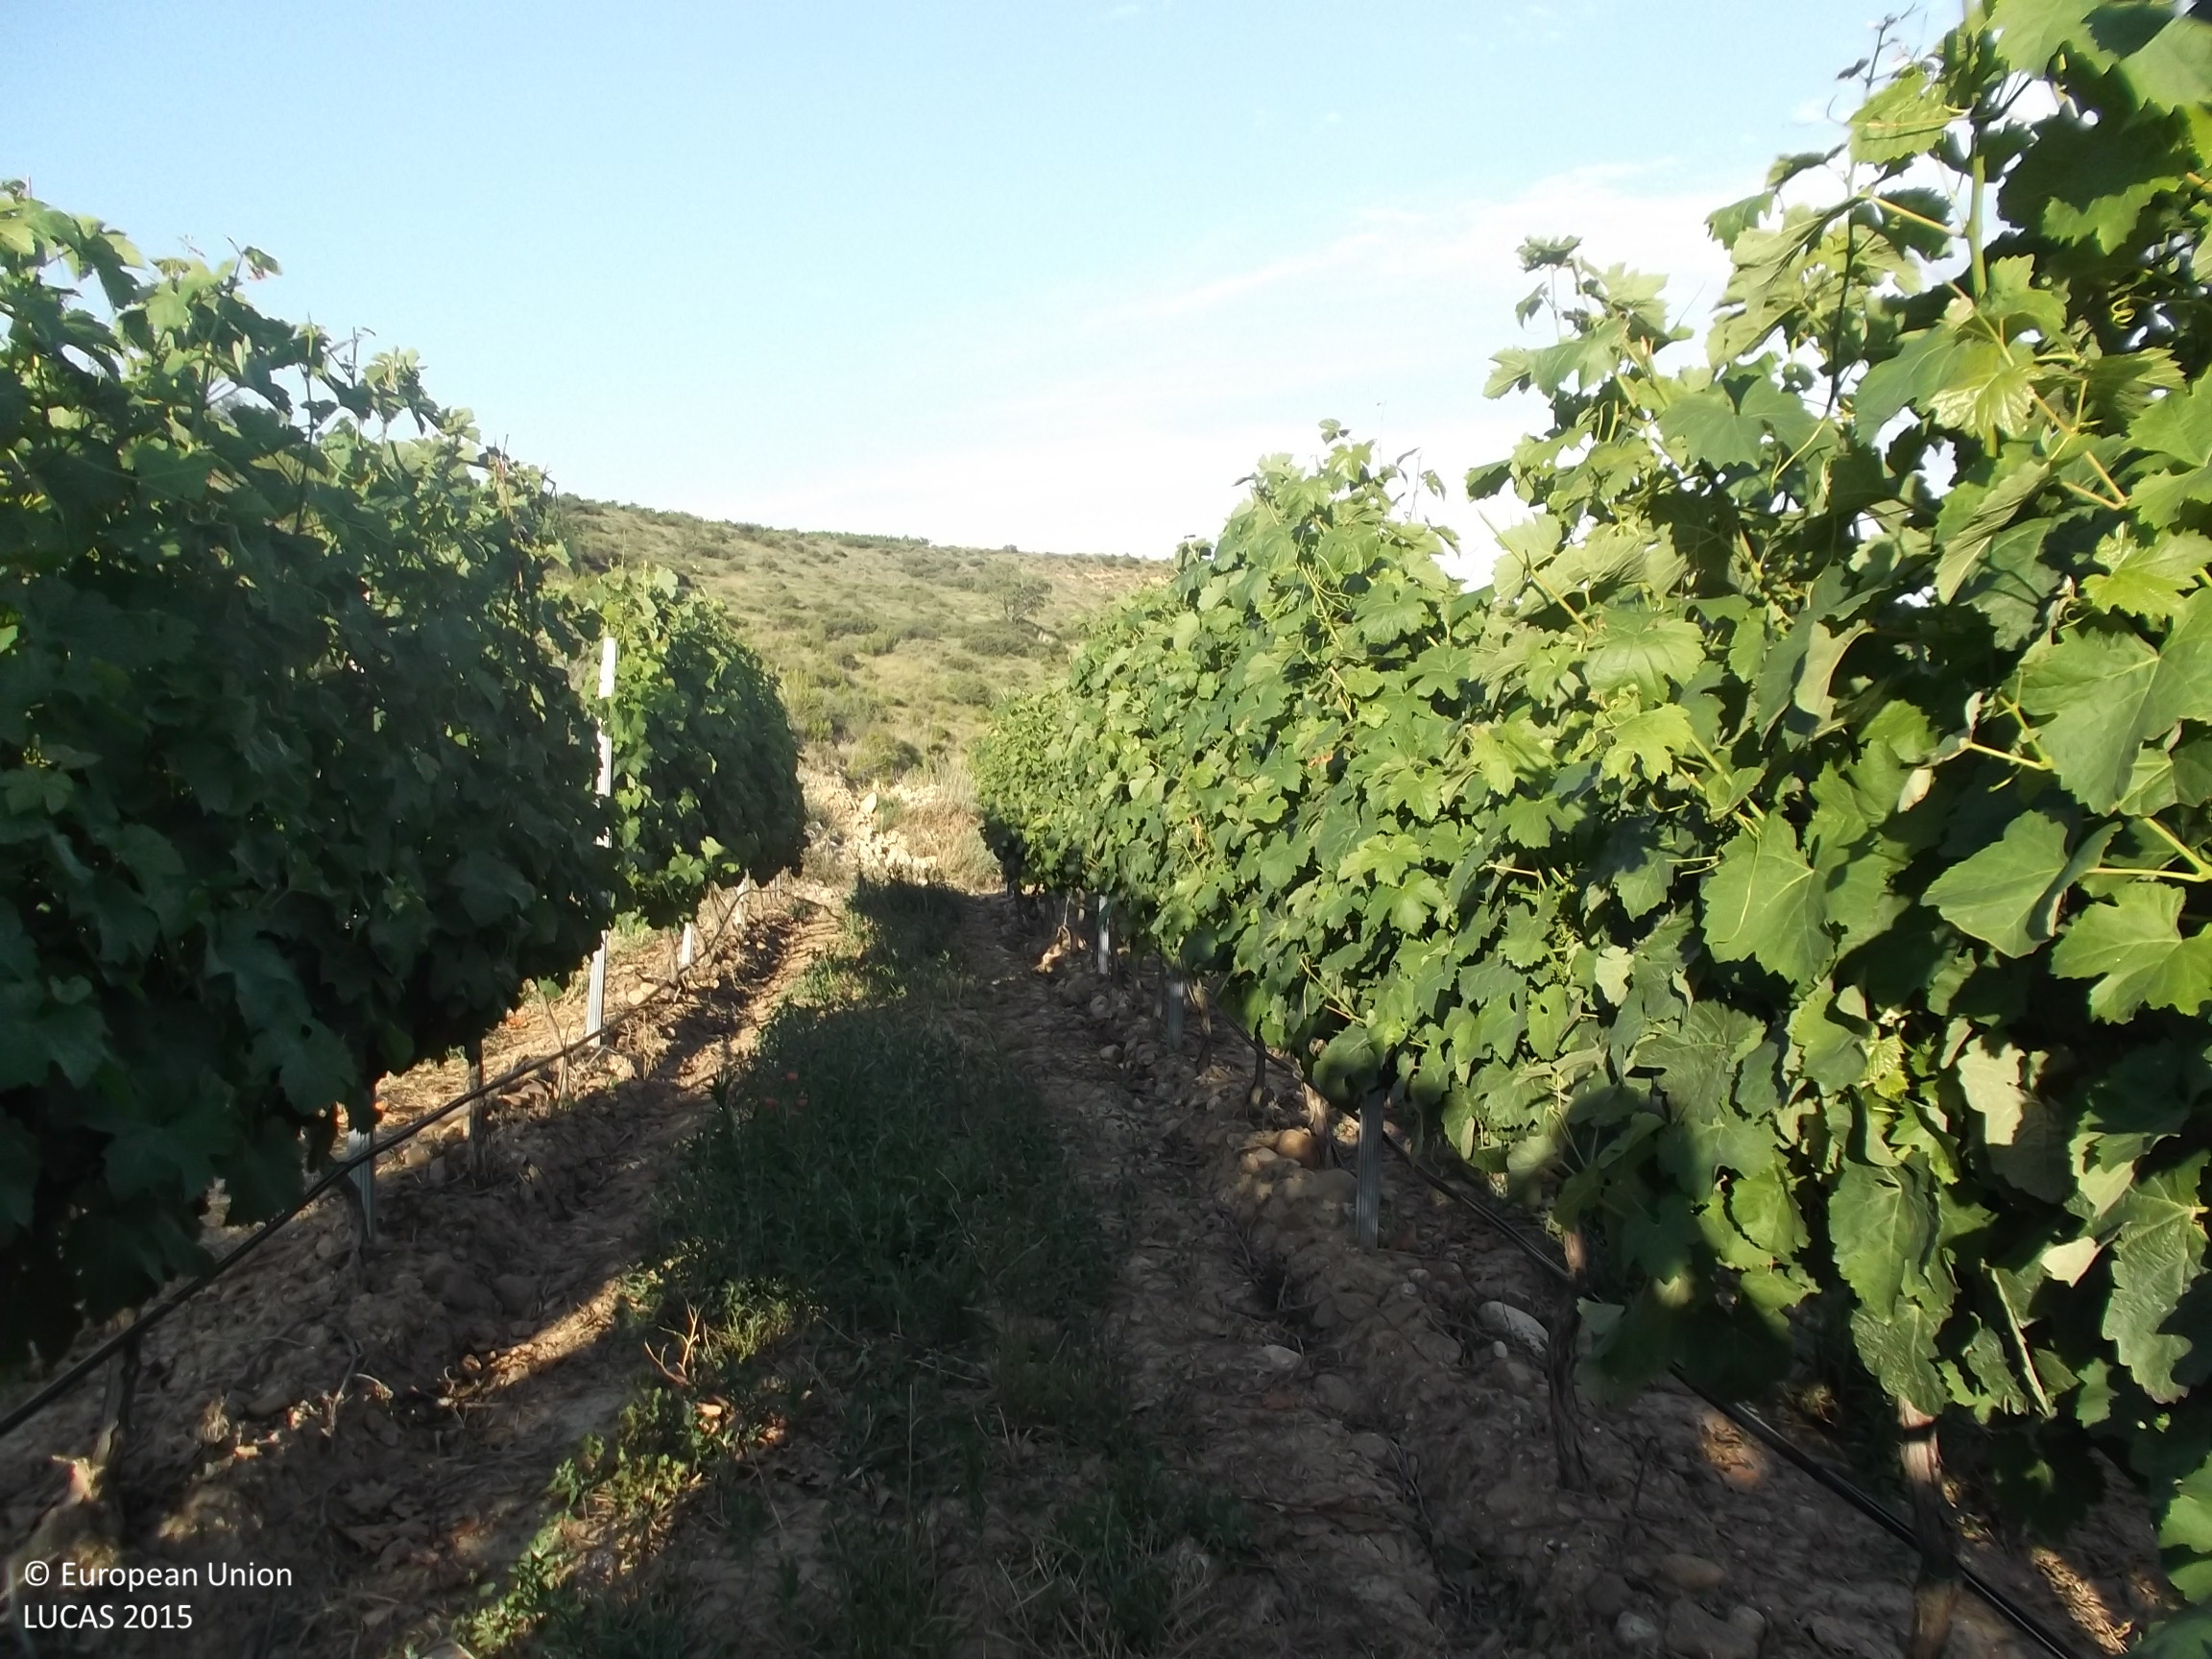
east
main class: Cropland
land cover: Vineyards
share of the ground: 10 - 25 %
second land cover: Spontaneously vegetated surfaces
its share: 25 - 50 %
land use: Agriculture (excluding fallow land and kitchen gardens)
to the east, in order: Vineyards; Spontaneously vegetated surfaces; Other bare soil; Grassland without tree/shrub cover; Pine dominated coniferous woodland; Shrubland without tree cover
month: June
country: ES
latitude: 42.3639
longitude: -2.0970
